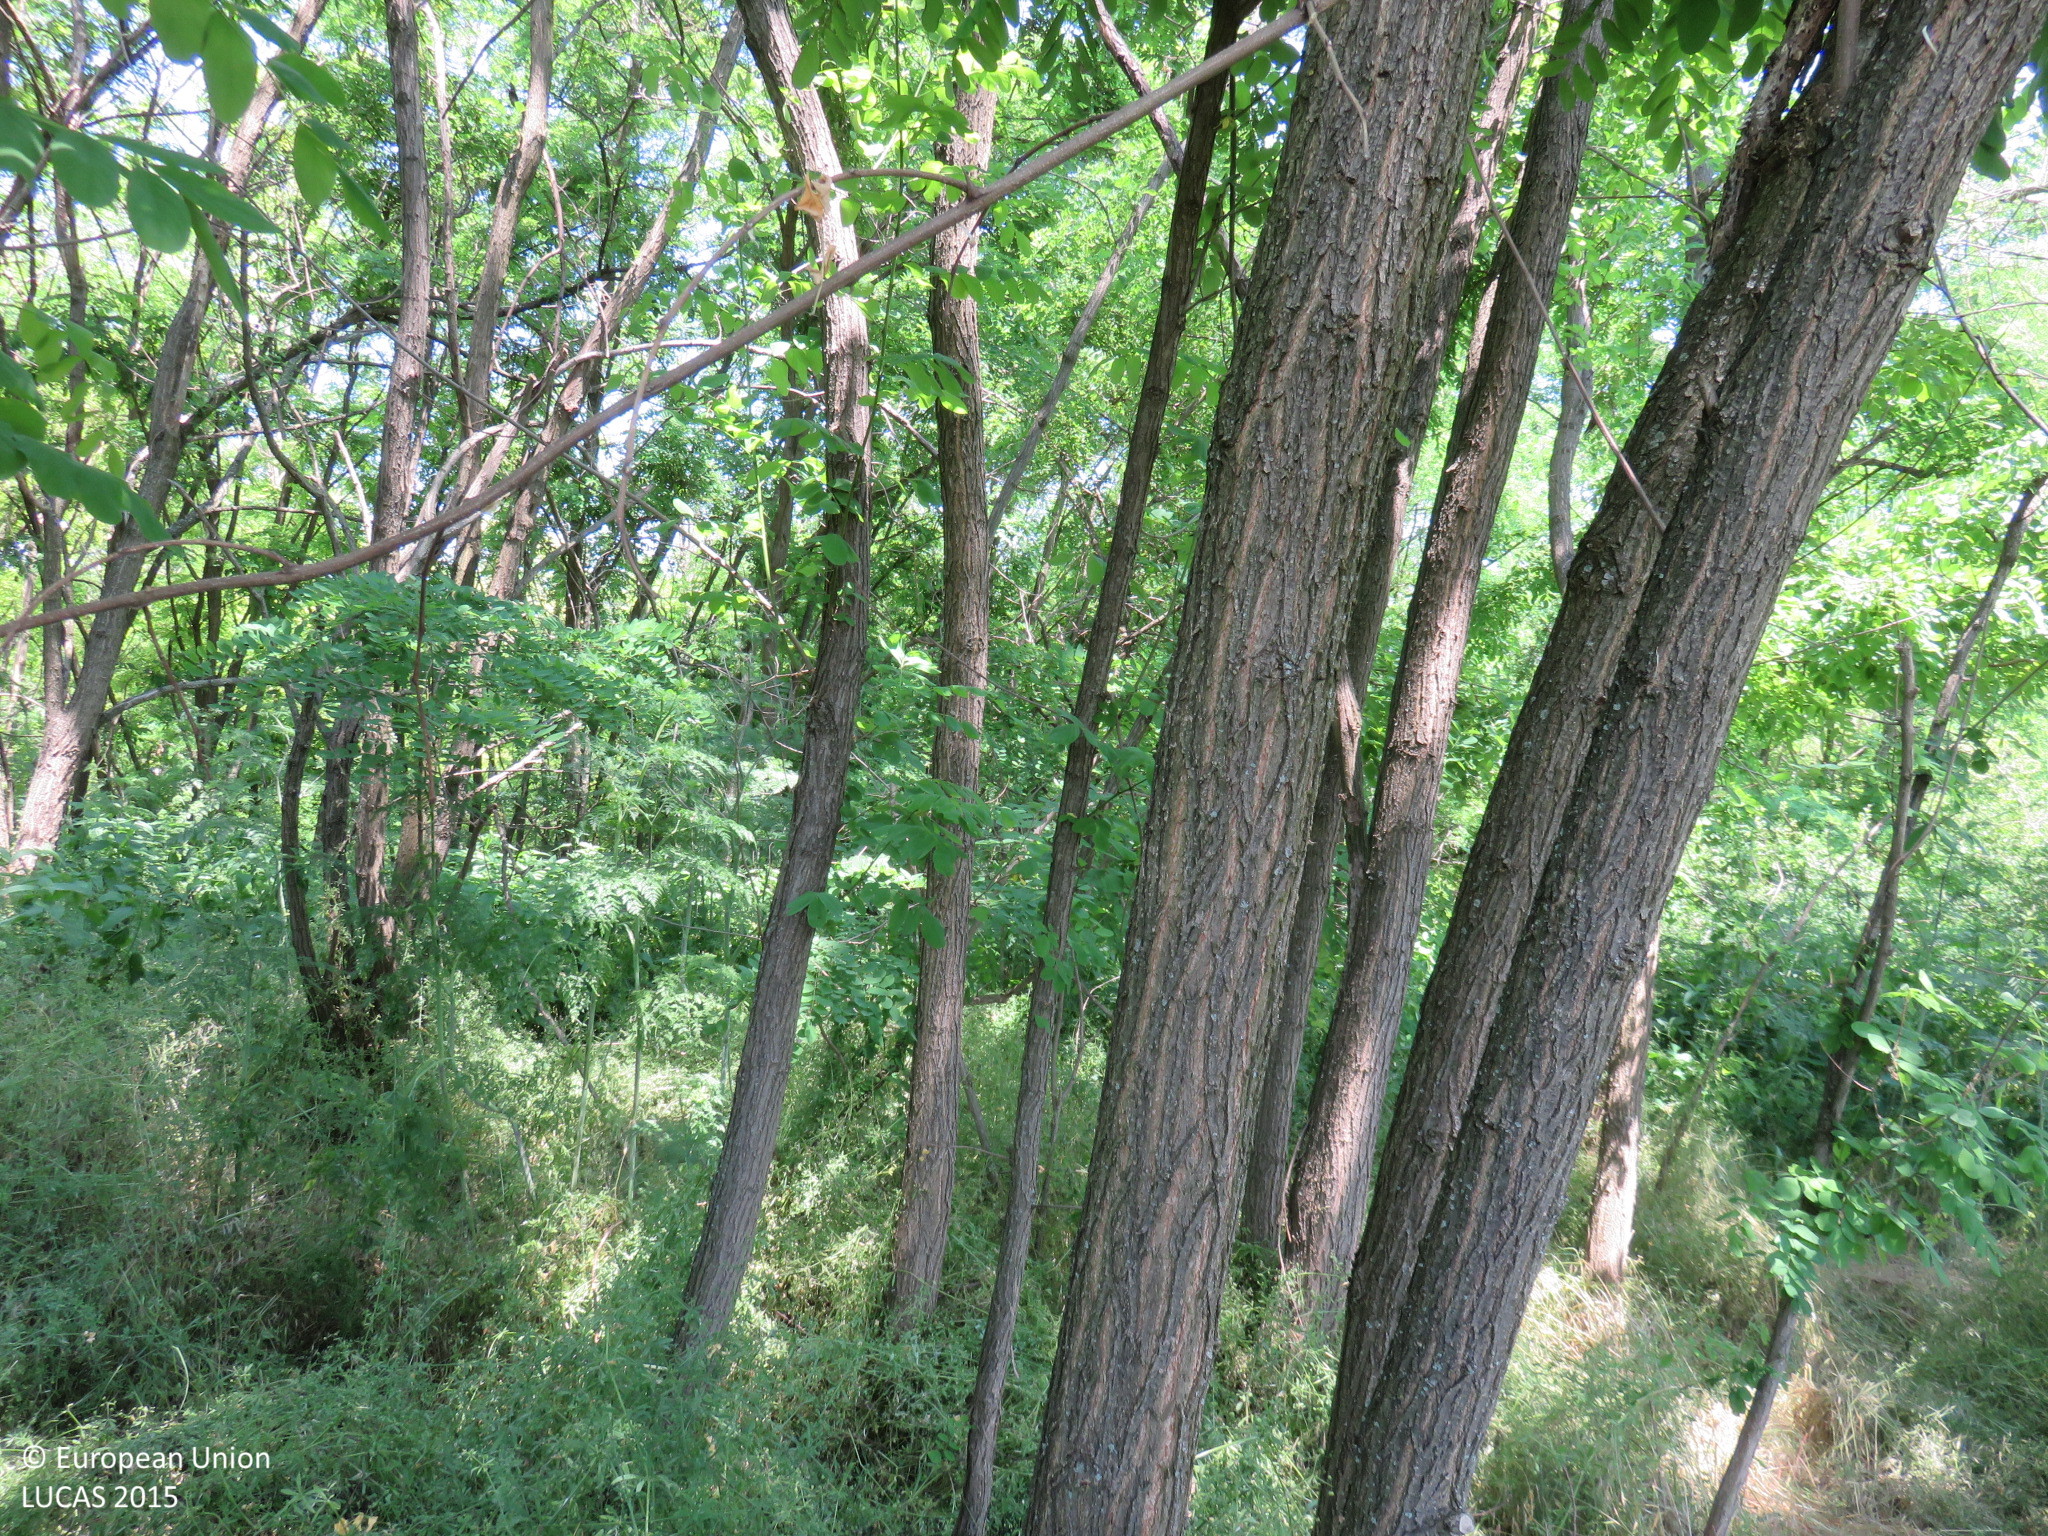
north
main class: Woodland
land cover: Broadleaved woodland
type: exotic forest
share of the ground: > 75 %
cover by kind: broadleaved forest trees 80 %, shrubs 10 %, herbaceous plants 10 %
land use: Forestry
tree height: < 5 m
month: June
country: BG
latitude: 43.3398
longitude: 24.5294
